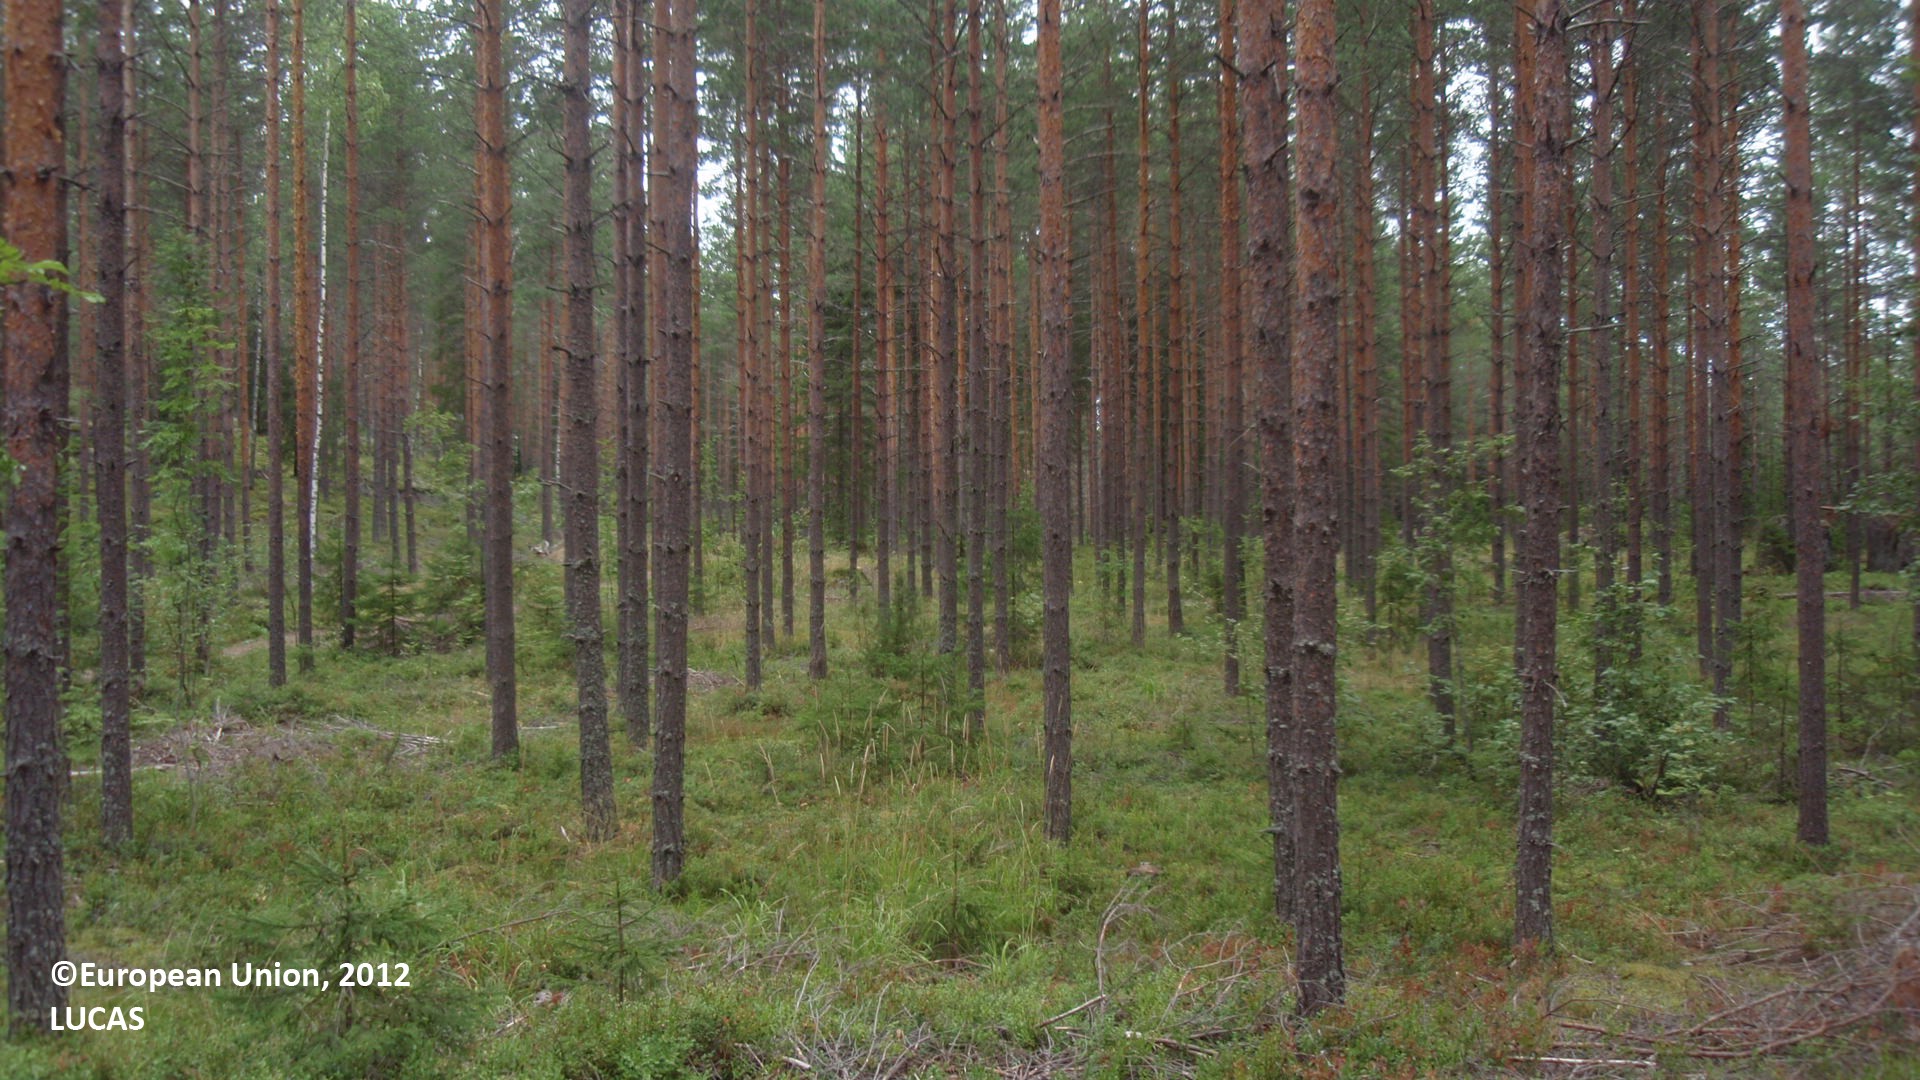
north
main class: Woodland
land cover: Pine dominated coniferous woodland
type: boreal forest
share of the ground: 50 - 75 %
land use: Forestry
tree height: > 5 m
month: August
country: FI
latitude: 60.7769
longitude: 27.3480
